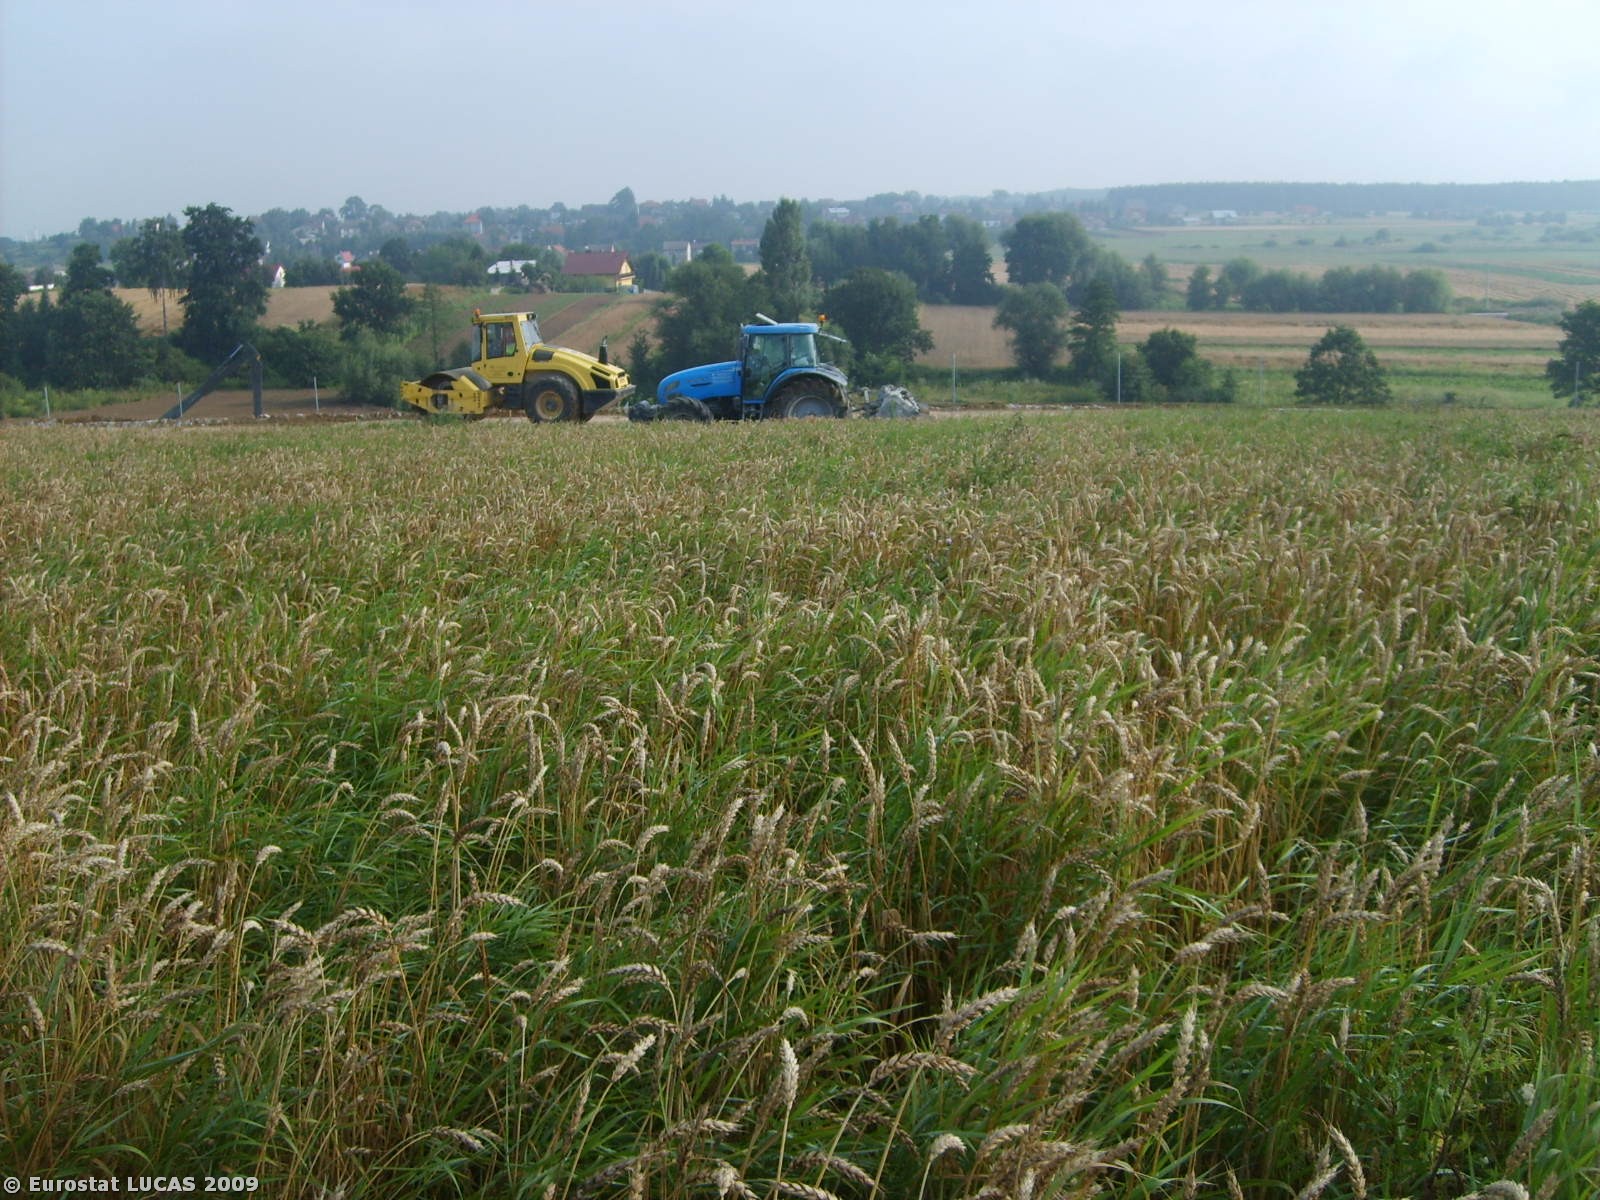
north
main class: Cropland
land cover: Common wheat
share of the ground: > 75 %
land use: Agriculture (excluding fallow land and kitchen gardens)
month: July
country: PL
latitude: 49.9971
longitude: 20.2040
